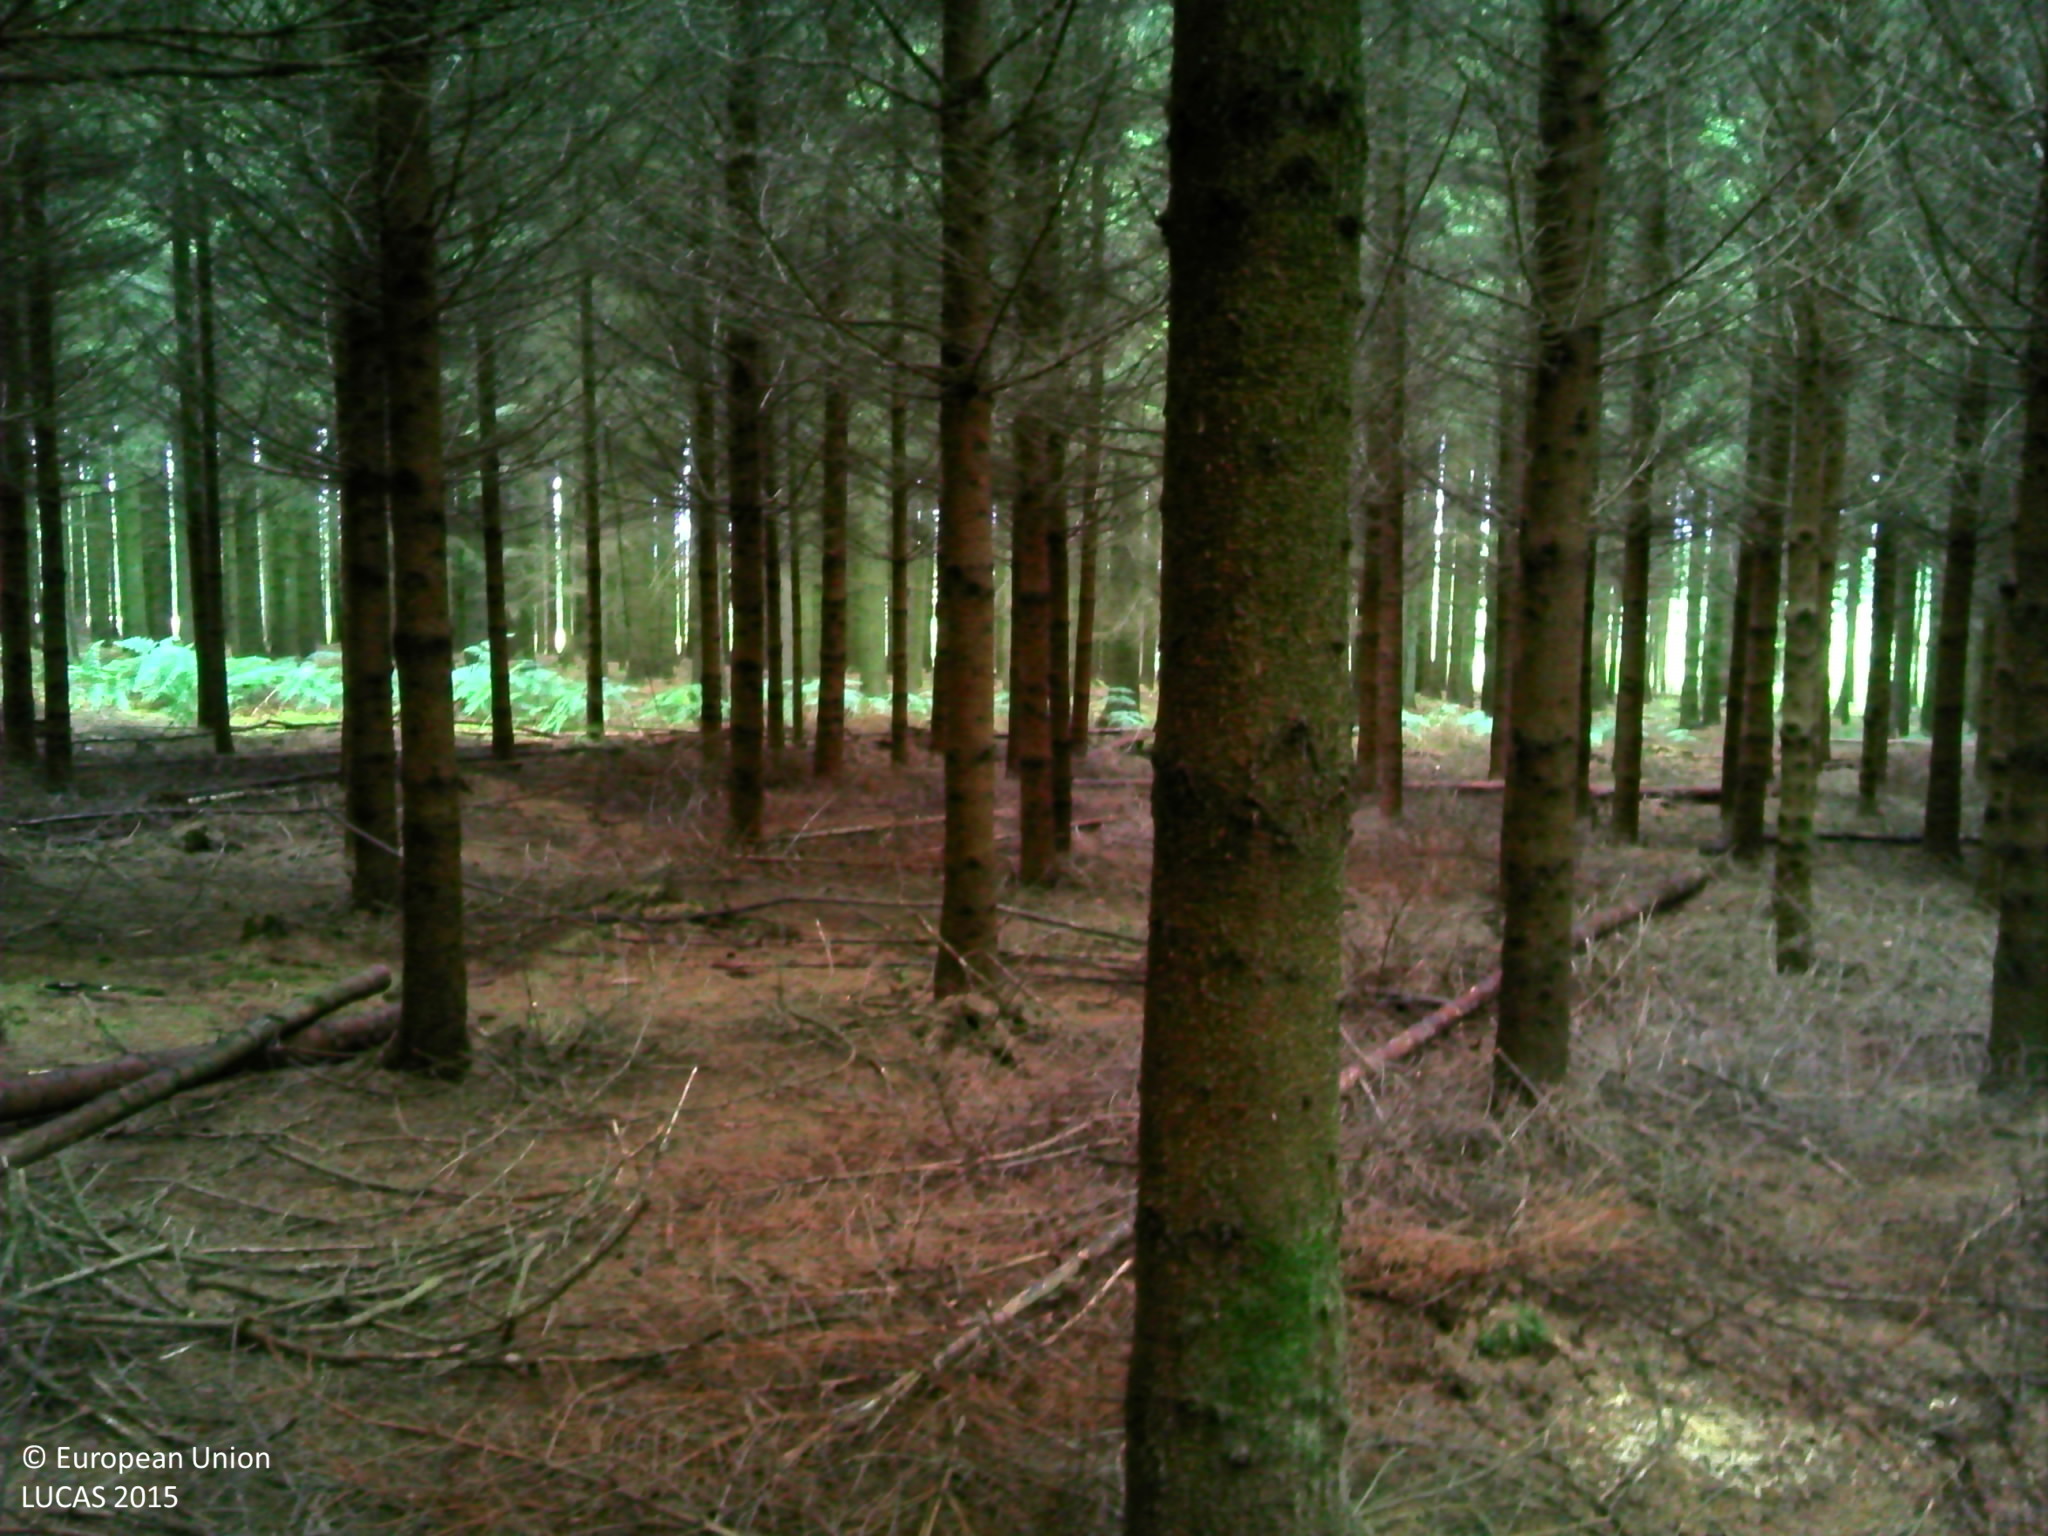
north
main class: Woodland
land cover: Spruce dominated coniferous woodland
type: alpine coniferous forest
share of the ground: > 75 %
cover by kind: coniferous forest trees 95 %, unconsolidated bare surface 5 %
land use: Forestry
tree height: > 5 m
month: July
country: BE
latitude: 50.0896
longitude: 5.8197
